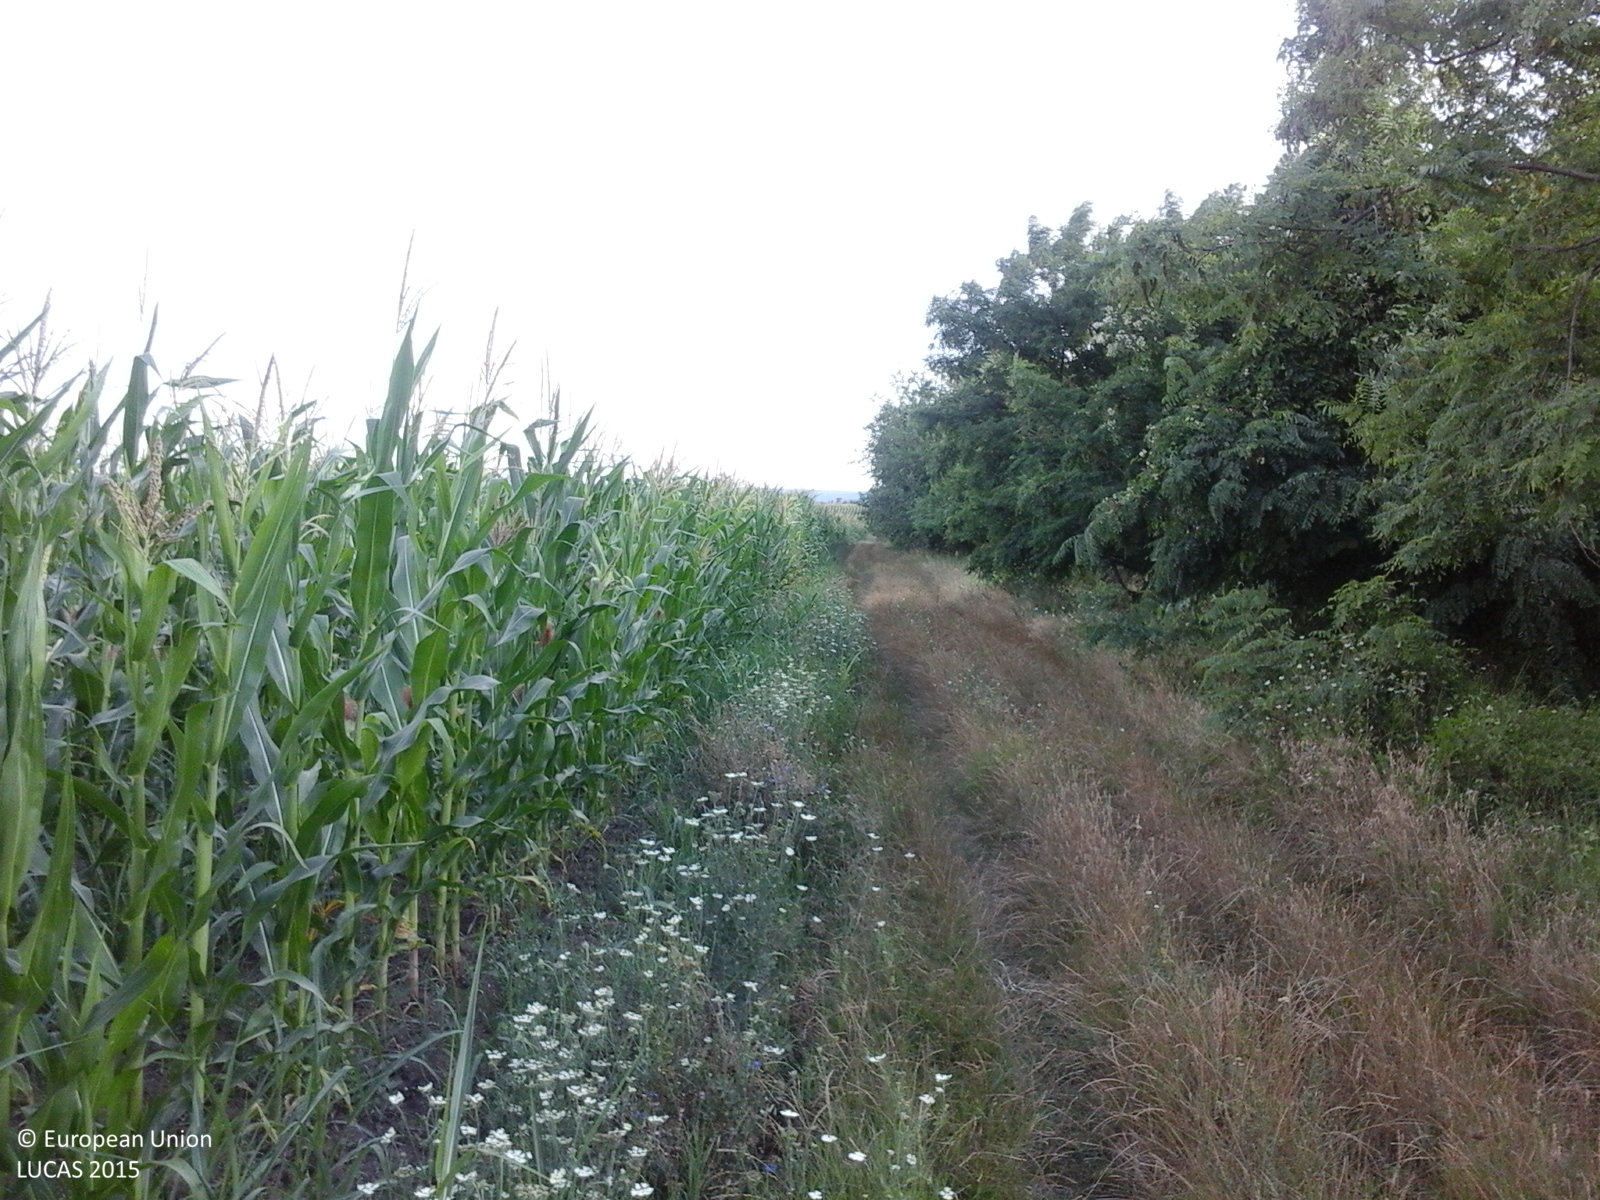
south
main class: Cropland
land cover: Maize
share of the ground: > 75 %
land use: Agriculture (excluding fallow land and kitchen gardens)
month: July
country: RO
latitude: 43.7660
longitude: 24.2331
